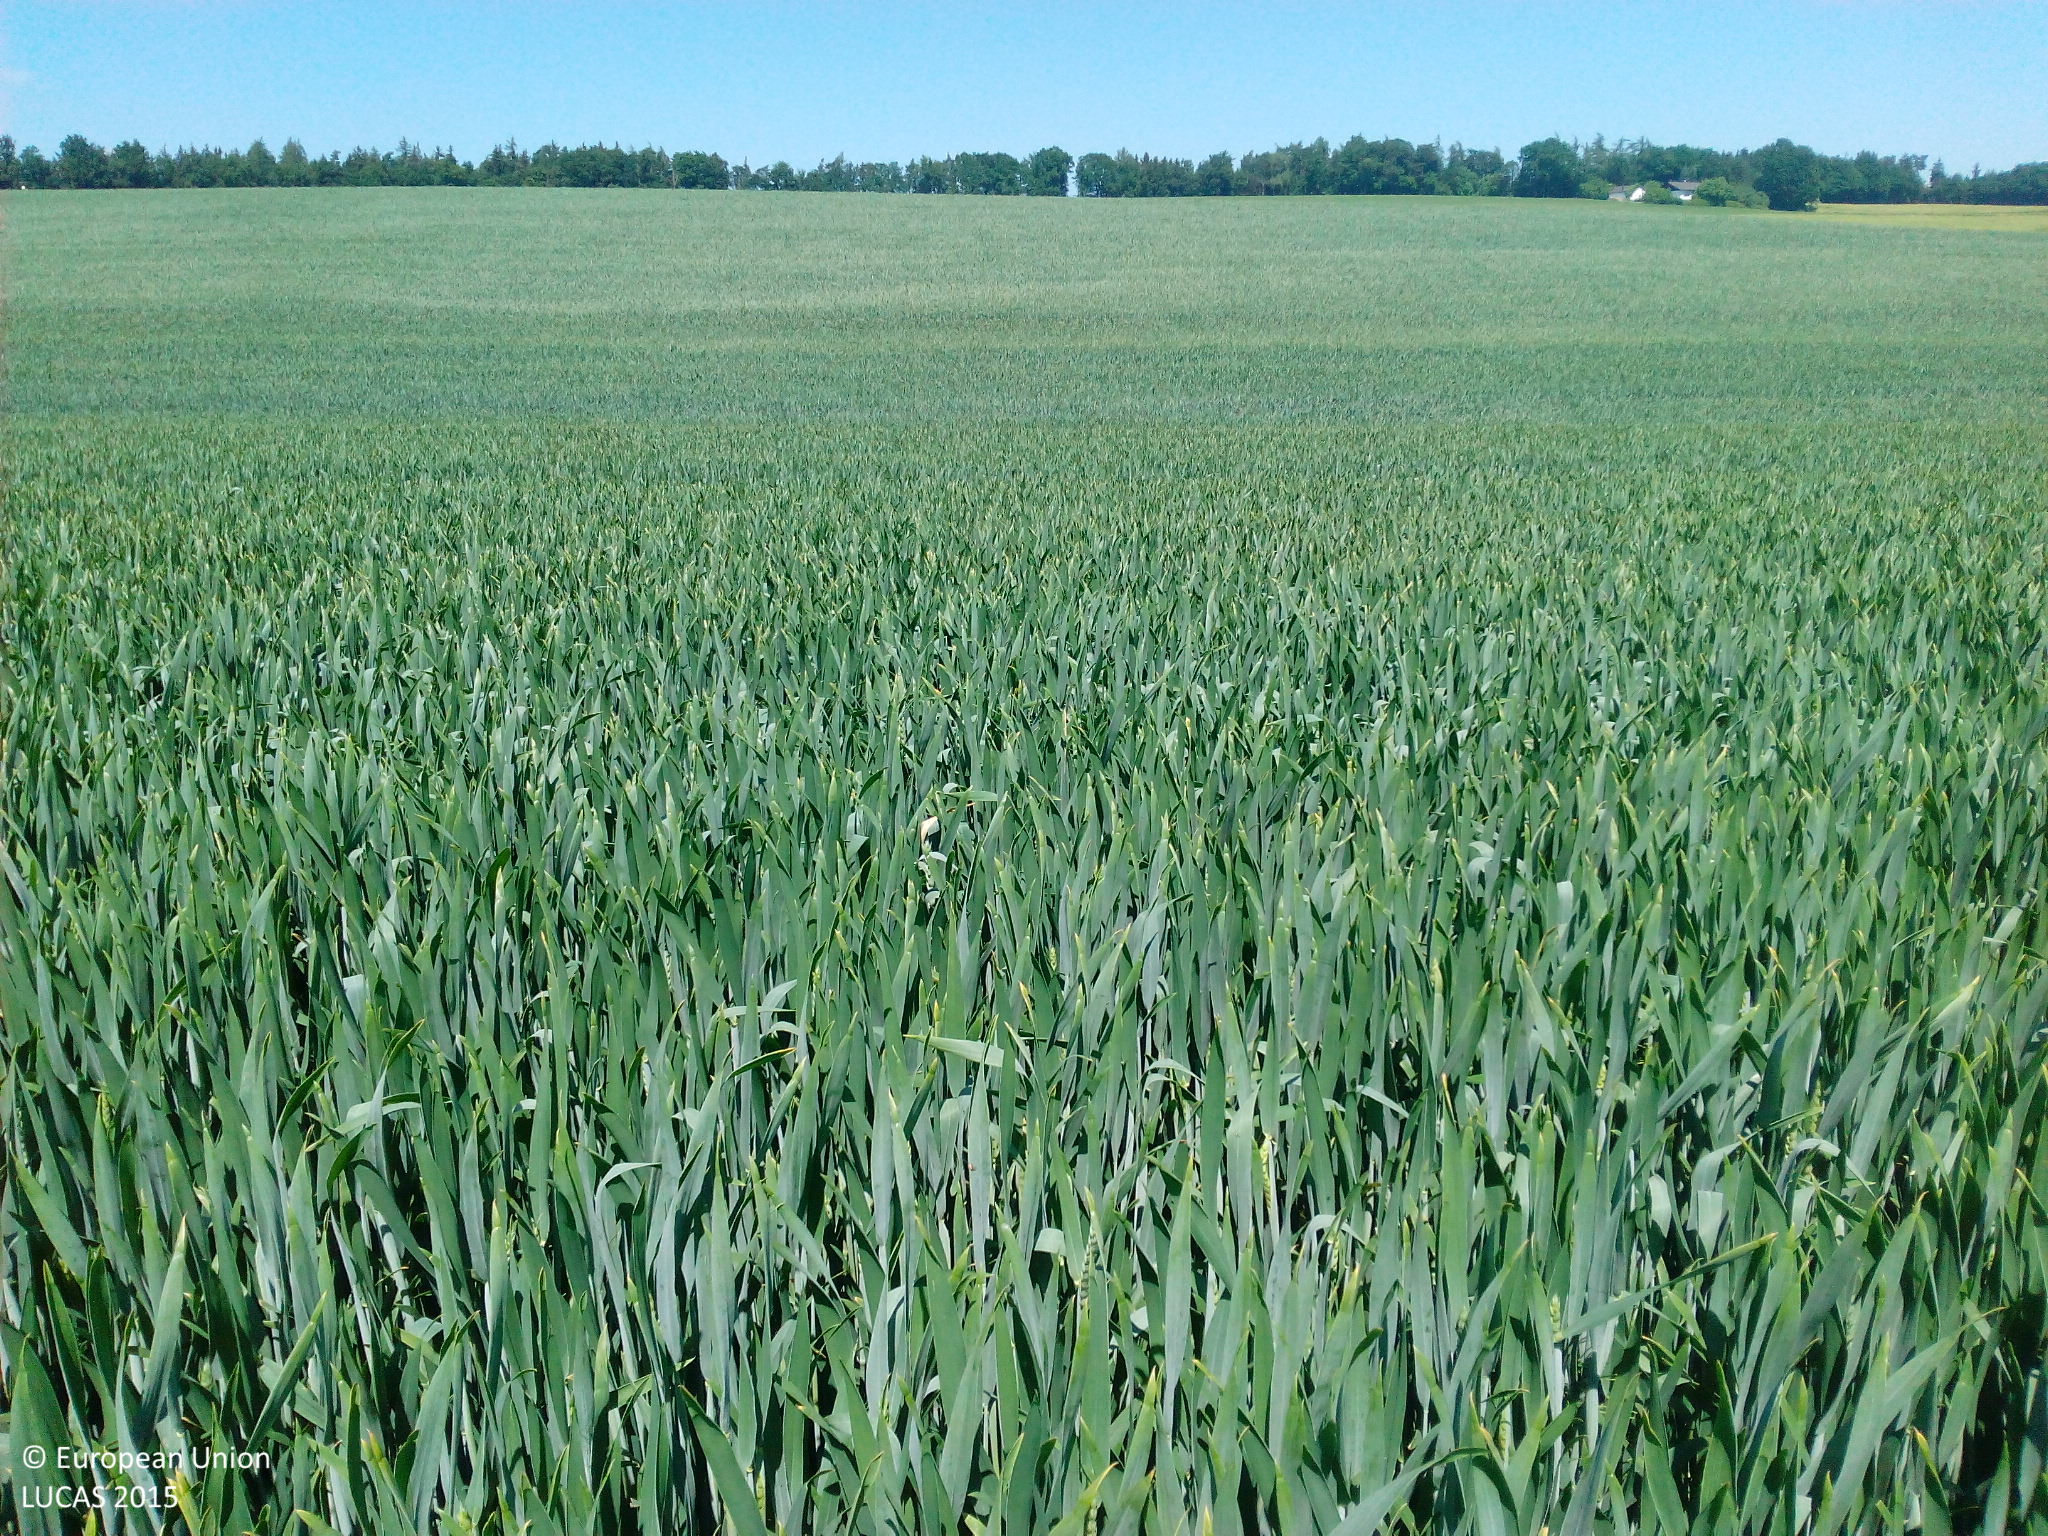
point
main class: Cropland
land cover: Common wheat
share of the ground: > 75 %
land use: Agriculture (excluding fallow land and kitchen gardens)
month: June
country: DE
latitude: 48.7553
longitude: 12.4069
